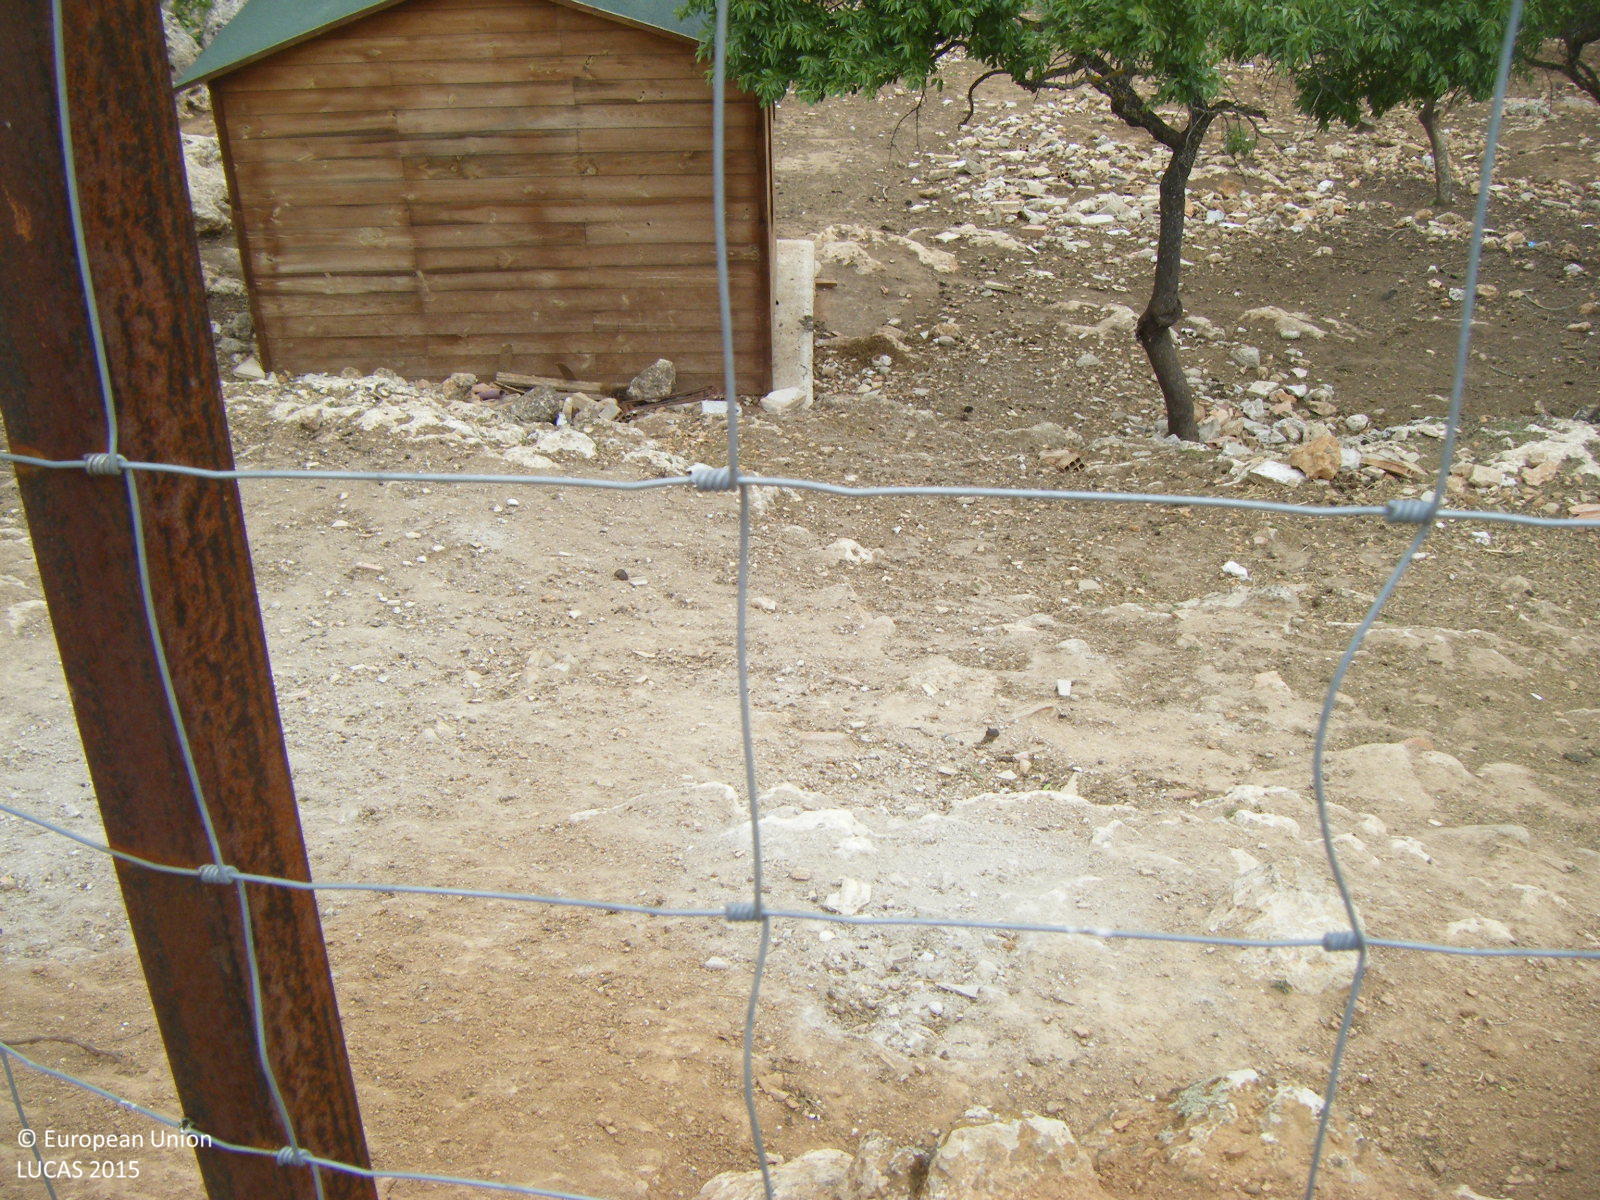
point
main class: Cropland
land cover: Nuts trees
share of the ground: < 10 %
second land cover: Other bare soil
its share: > 75 %
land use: Agriculture (excluding fallow land and kitchen gardens)
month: April
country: ES
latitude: 37.1616
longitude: -4.1495
